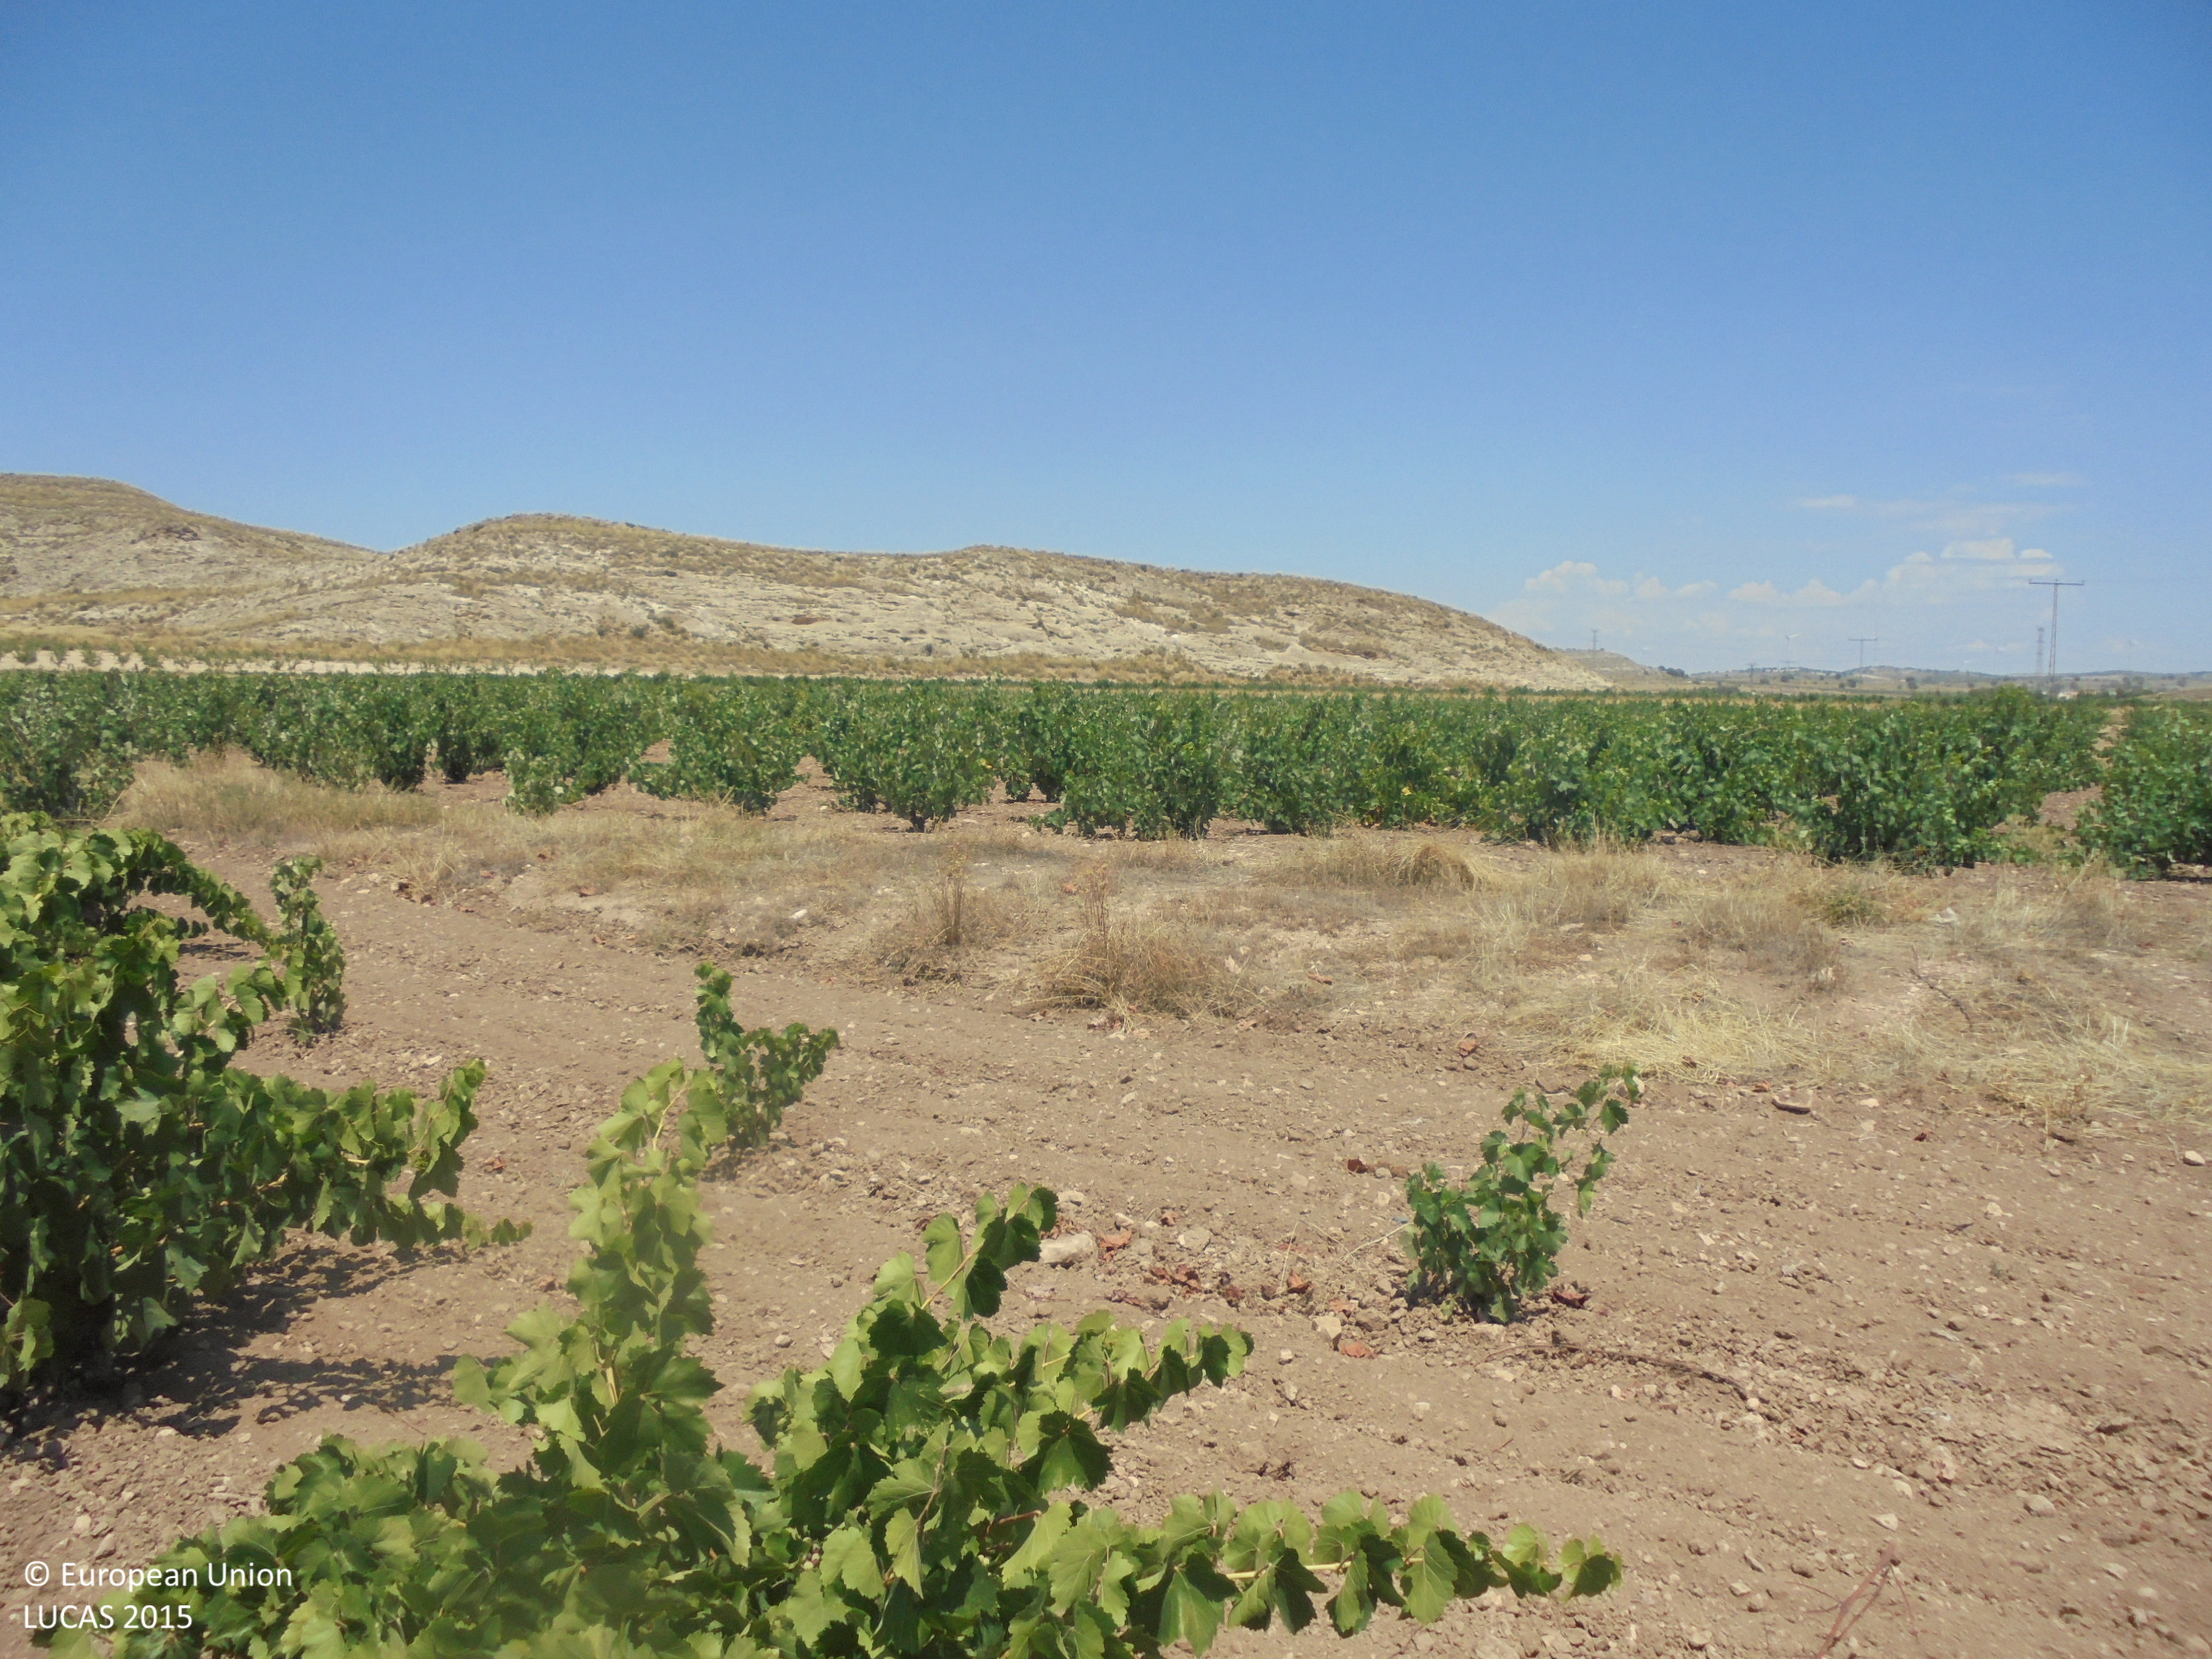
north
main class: Cropland
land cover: Vineyards
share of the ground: 25 - 50 %
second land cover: Other bare soil
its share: > 75 %
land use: Agriculture (excluding fallow land and kitchen gardens)
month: July
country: ES
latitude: 38.5429
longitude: -1.3848
